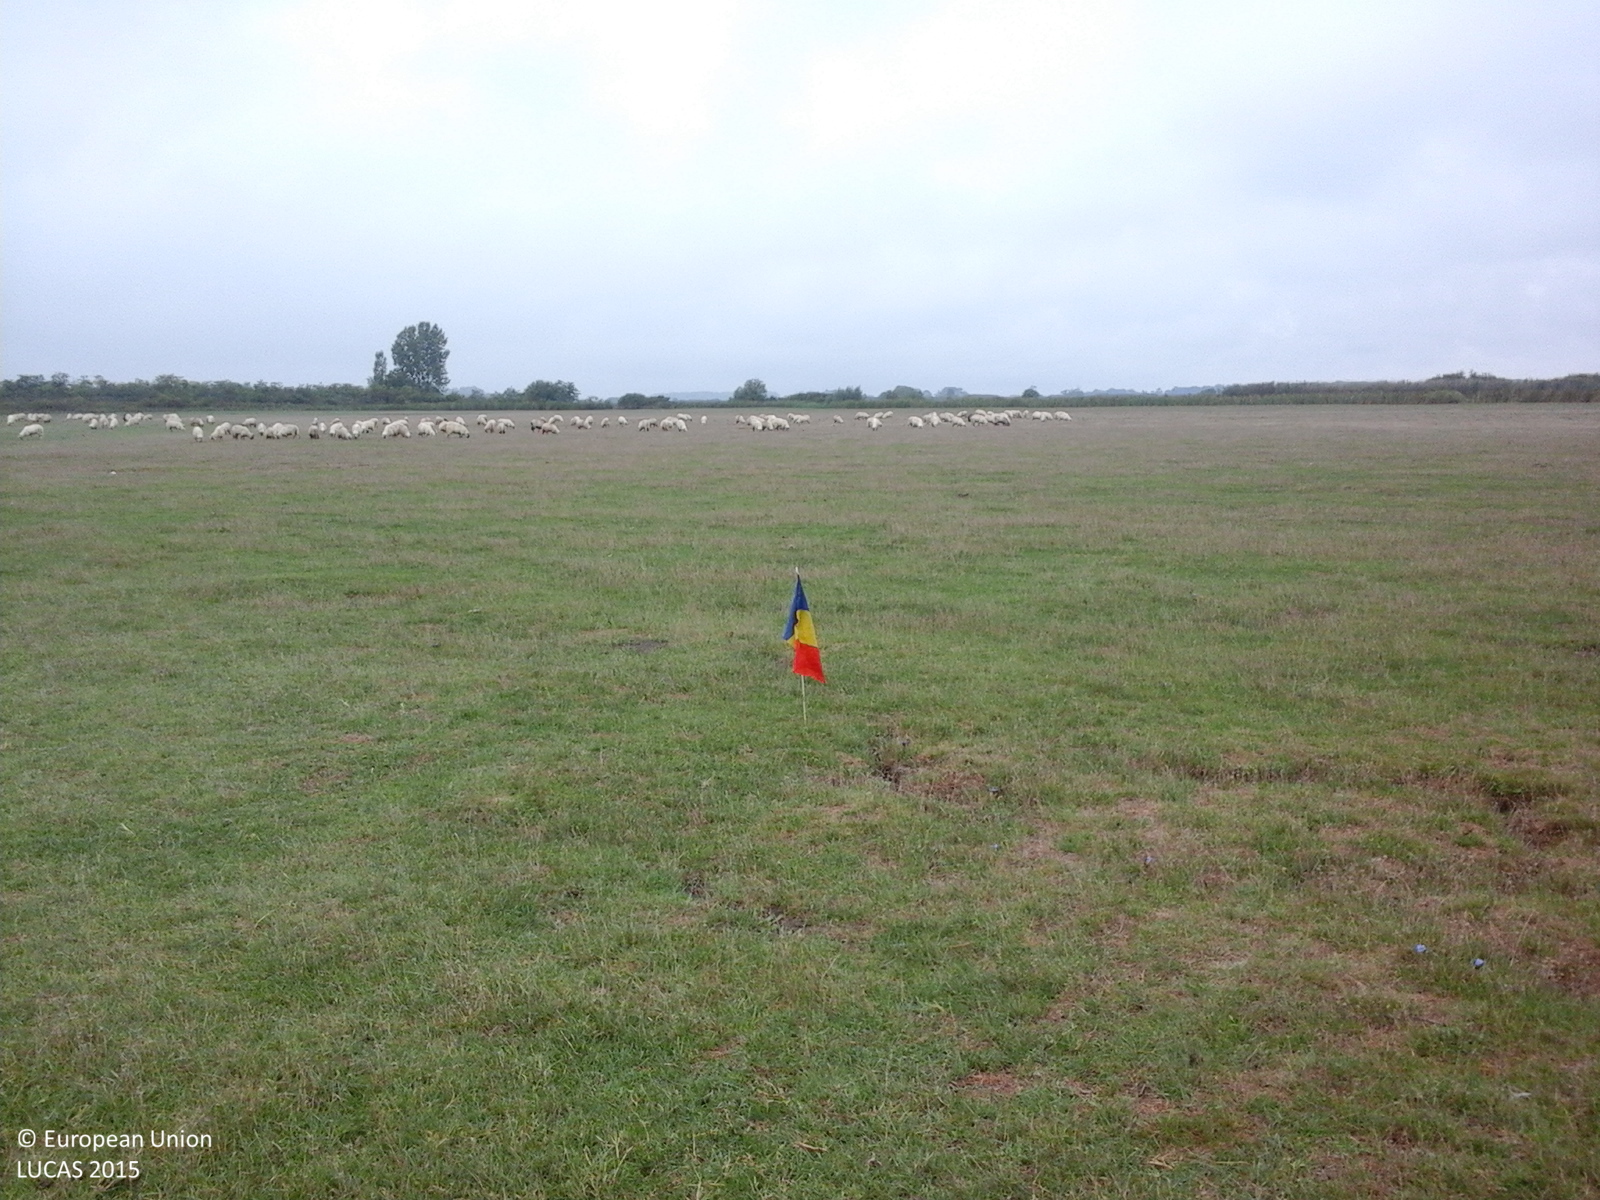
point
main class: Grassland
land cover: Grassland without tree/shrub cover
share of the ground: > 75 %
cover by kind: herbaceous plants 100 %
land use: Agriculture (excluding fallow land and kitchen gardens)
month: September
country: RO
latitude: 46.9823
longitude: 21.6775
